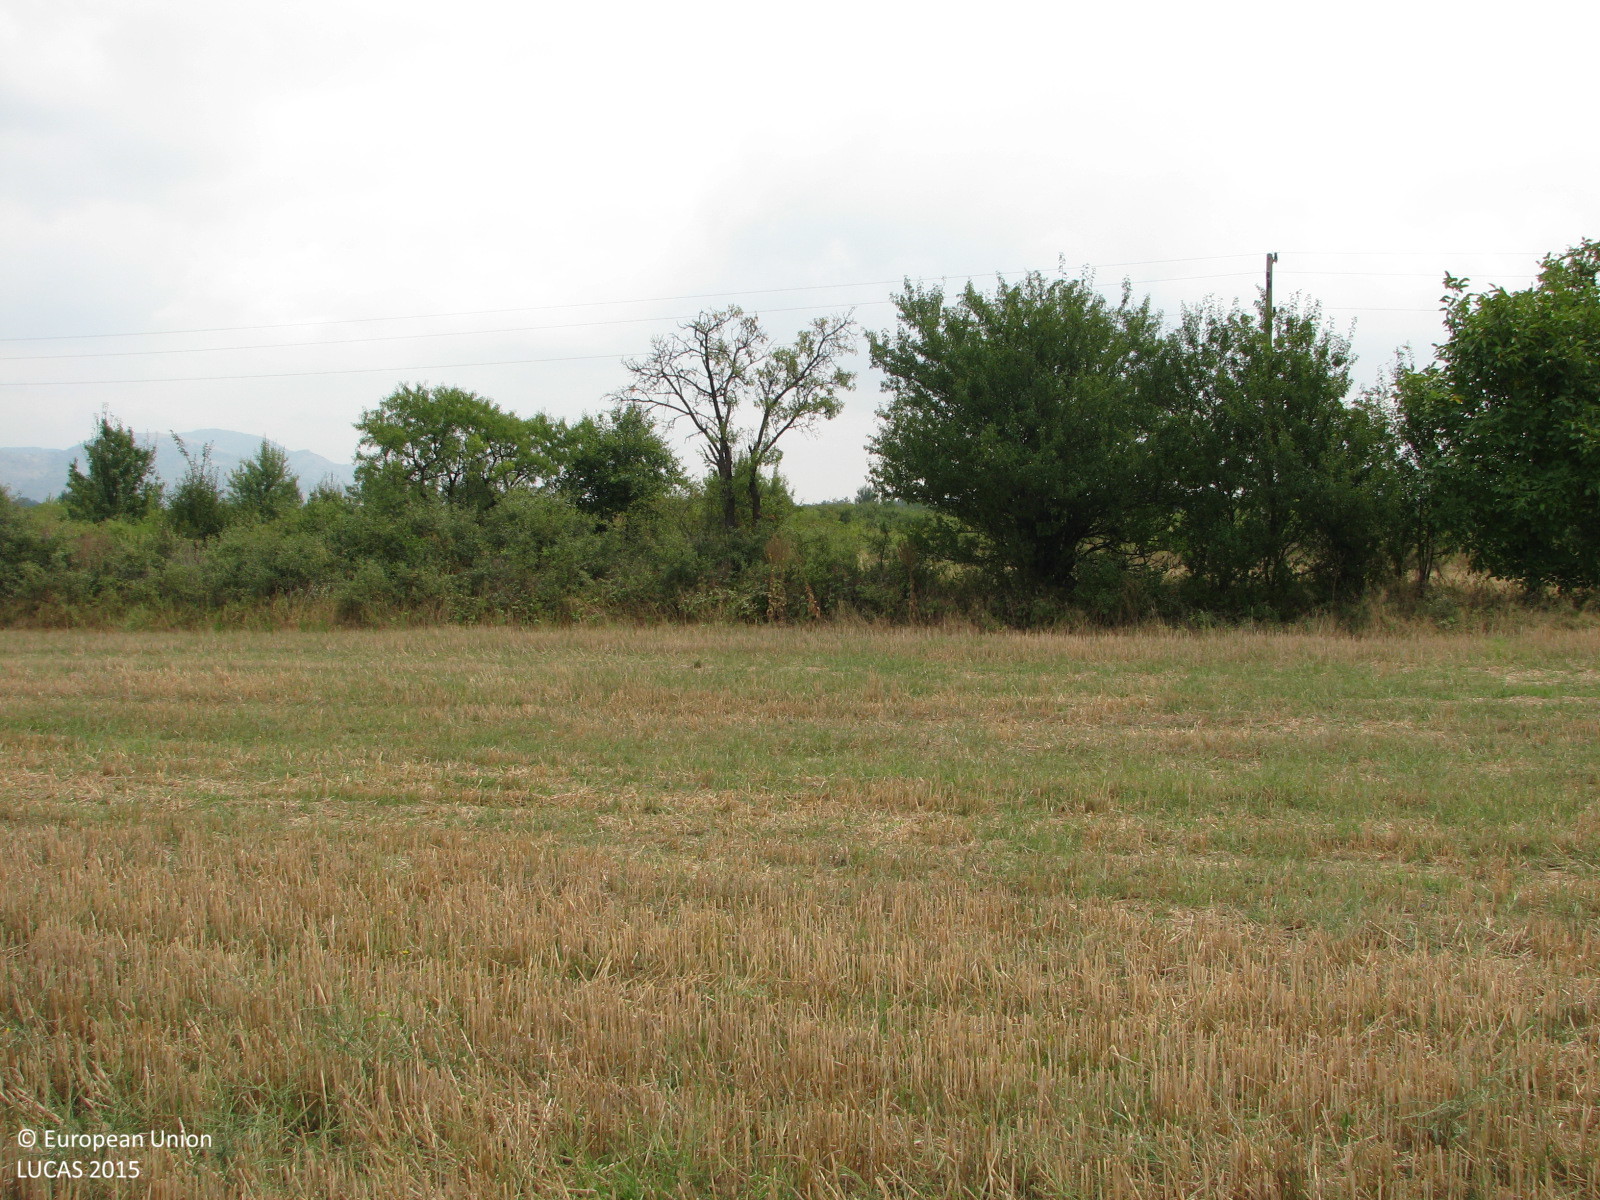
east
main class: Cropland
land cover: Common wheat
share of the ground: 25 - 50 %
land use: Agriculture (excluding fallow land and kitchen gardens)
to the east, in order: Common wheat; Lines of trees; Paved roads, cycling and walking lanes; Lines of trees; Grassland with sparse tree/shrub cover; Ditches and canals; Grassland with sparse tree/shrub cover; Shrubland with sparse tree cover; Electric lines; Shrubland with sparse tree cover; Ditches and canals; Shrubland with sparse tree cover
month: August
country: BG
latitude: 42.6405
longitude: 25.9981
